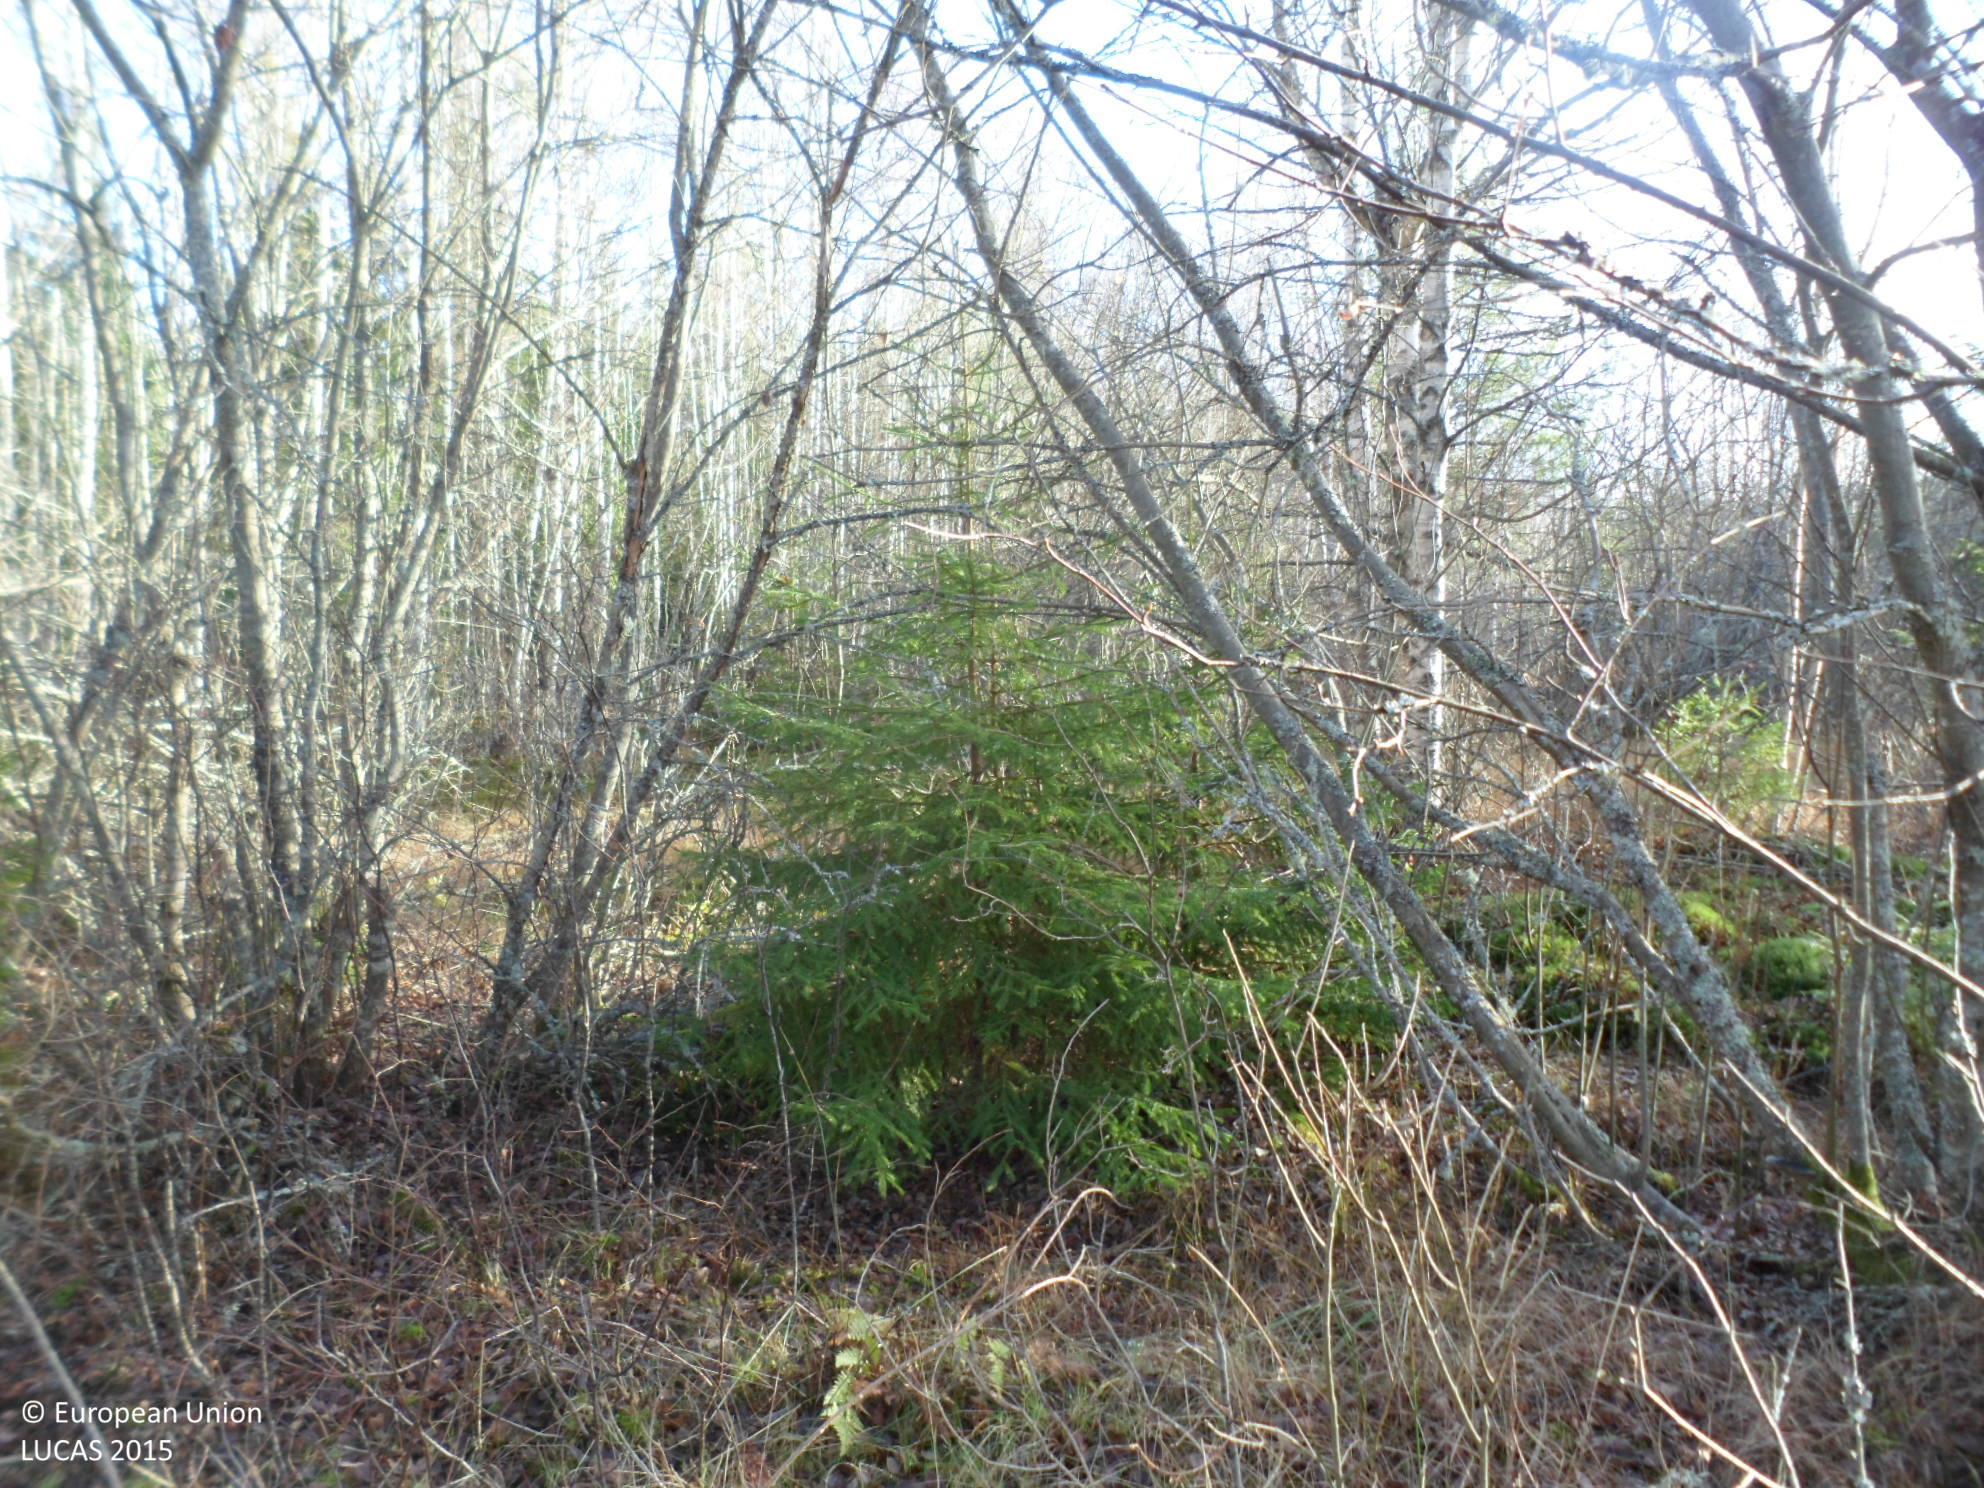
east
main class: Woodland
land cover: Broadleaved woodland
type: boreal forest
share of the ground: 50 - 75 %
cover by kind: broadleaved forest trees 50 %, shrubs 25 %, herbaceous plants 10 %, lichens and mosses 10 %, coniferous forest trees 5 %
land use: Forestry
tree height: > 5 m
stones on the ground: < 10 %
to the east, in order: Broadleaved woodland; Pine dominated mixed woodland; Pine dominated coniferous woodland; Broadleaved woodland; Pine dominated coniferous woodland; Pine dominated mixed woodland
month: November
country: SE
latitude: 57.2310
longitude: 16.1447
